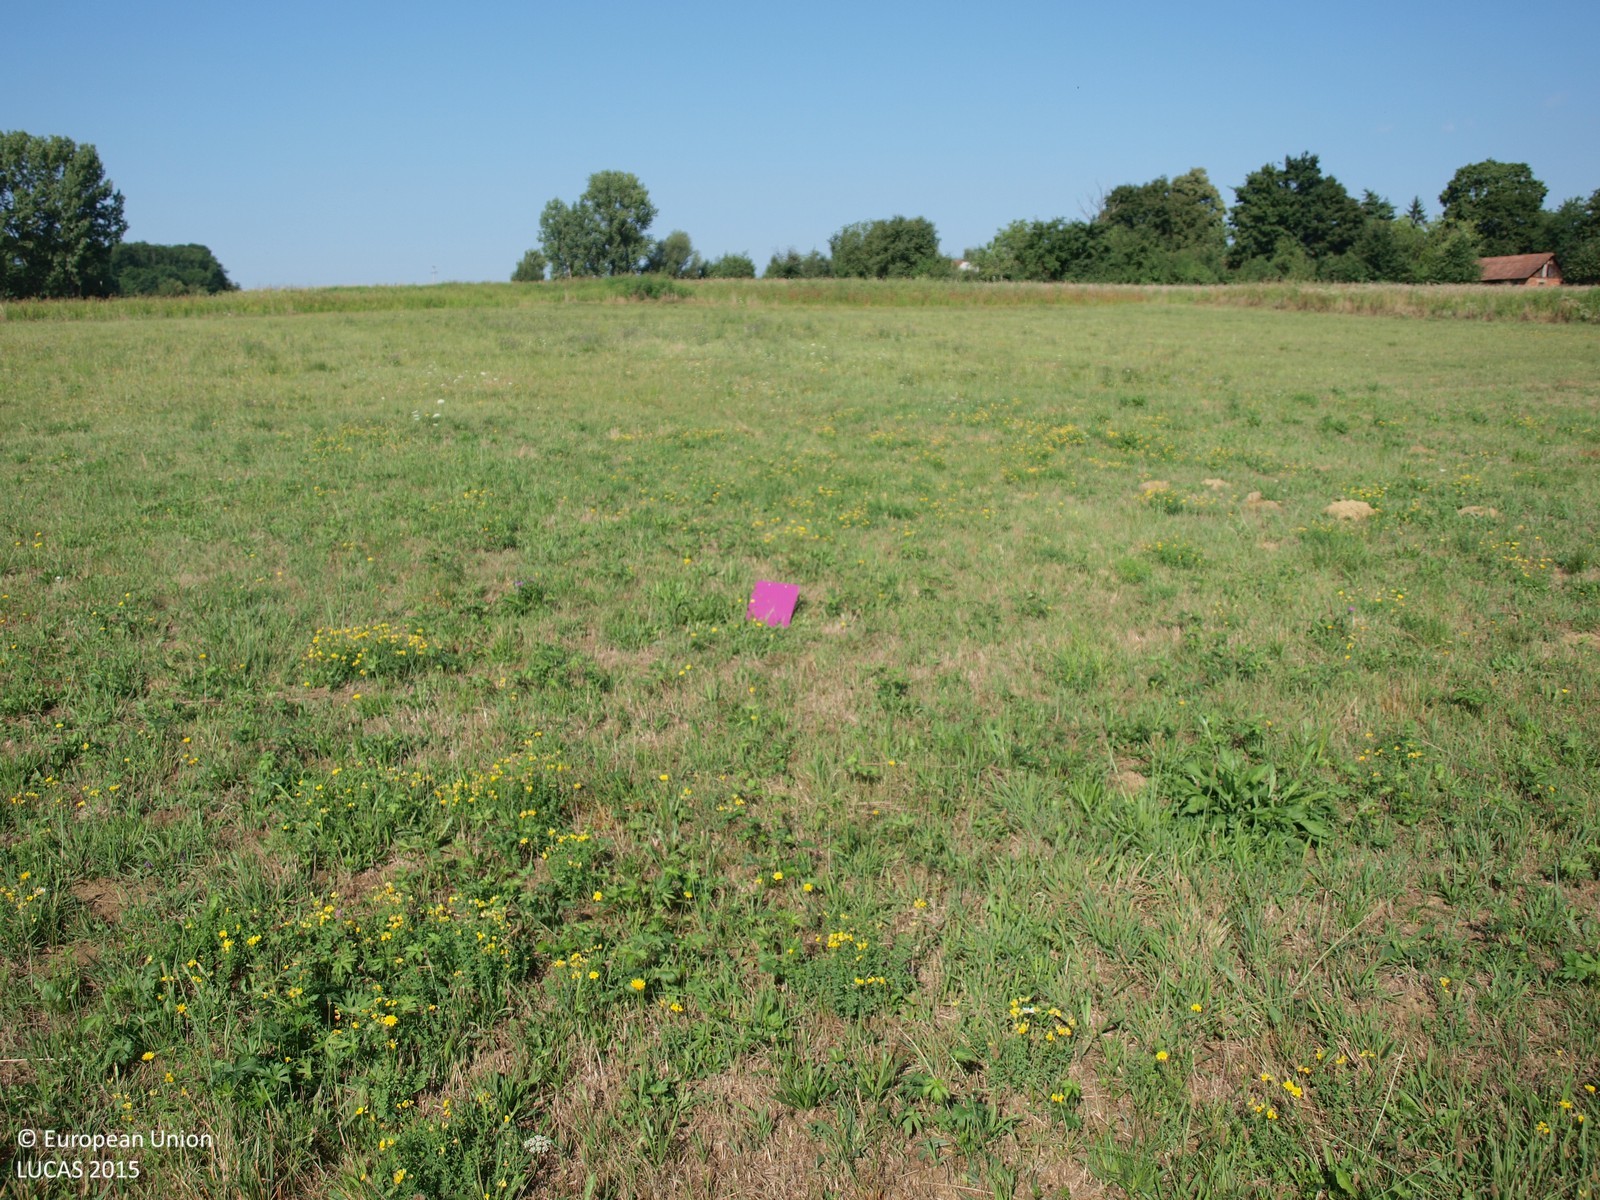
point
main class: Grassland
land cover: Grassland without tree/shrub cover
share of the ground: > 75 %
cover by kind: herbaceous plants 100 %
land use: Agriculture (excluding fallow land and kitchen gardens)
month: August
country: HR
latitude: 45.8974
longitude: 16.2497
